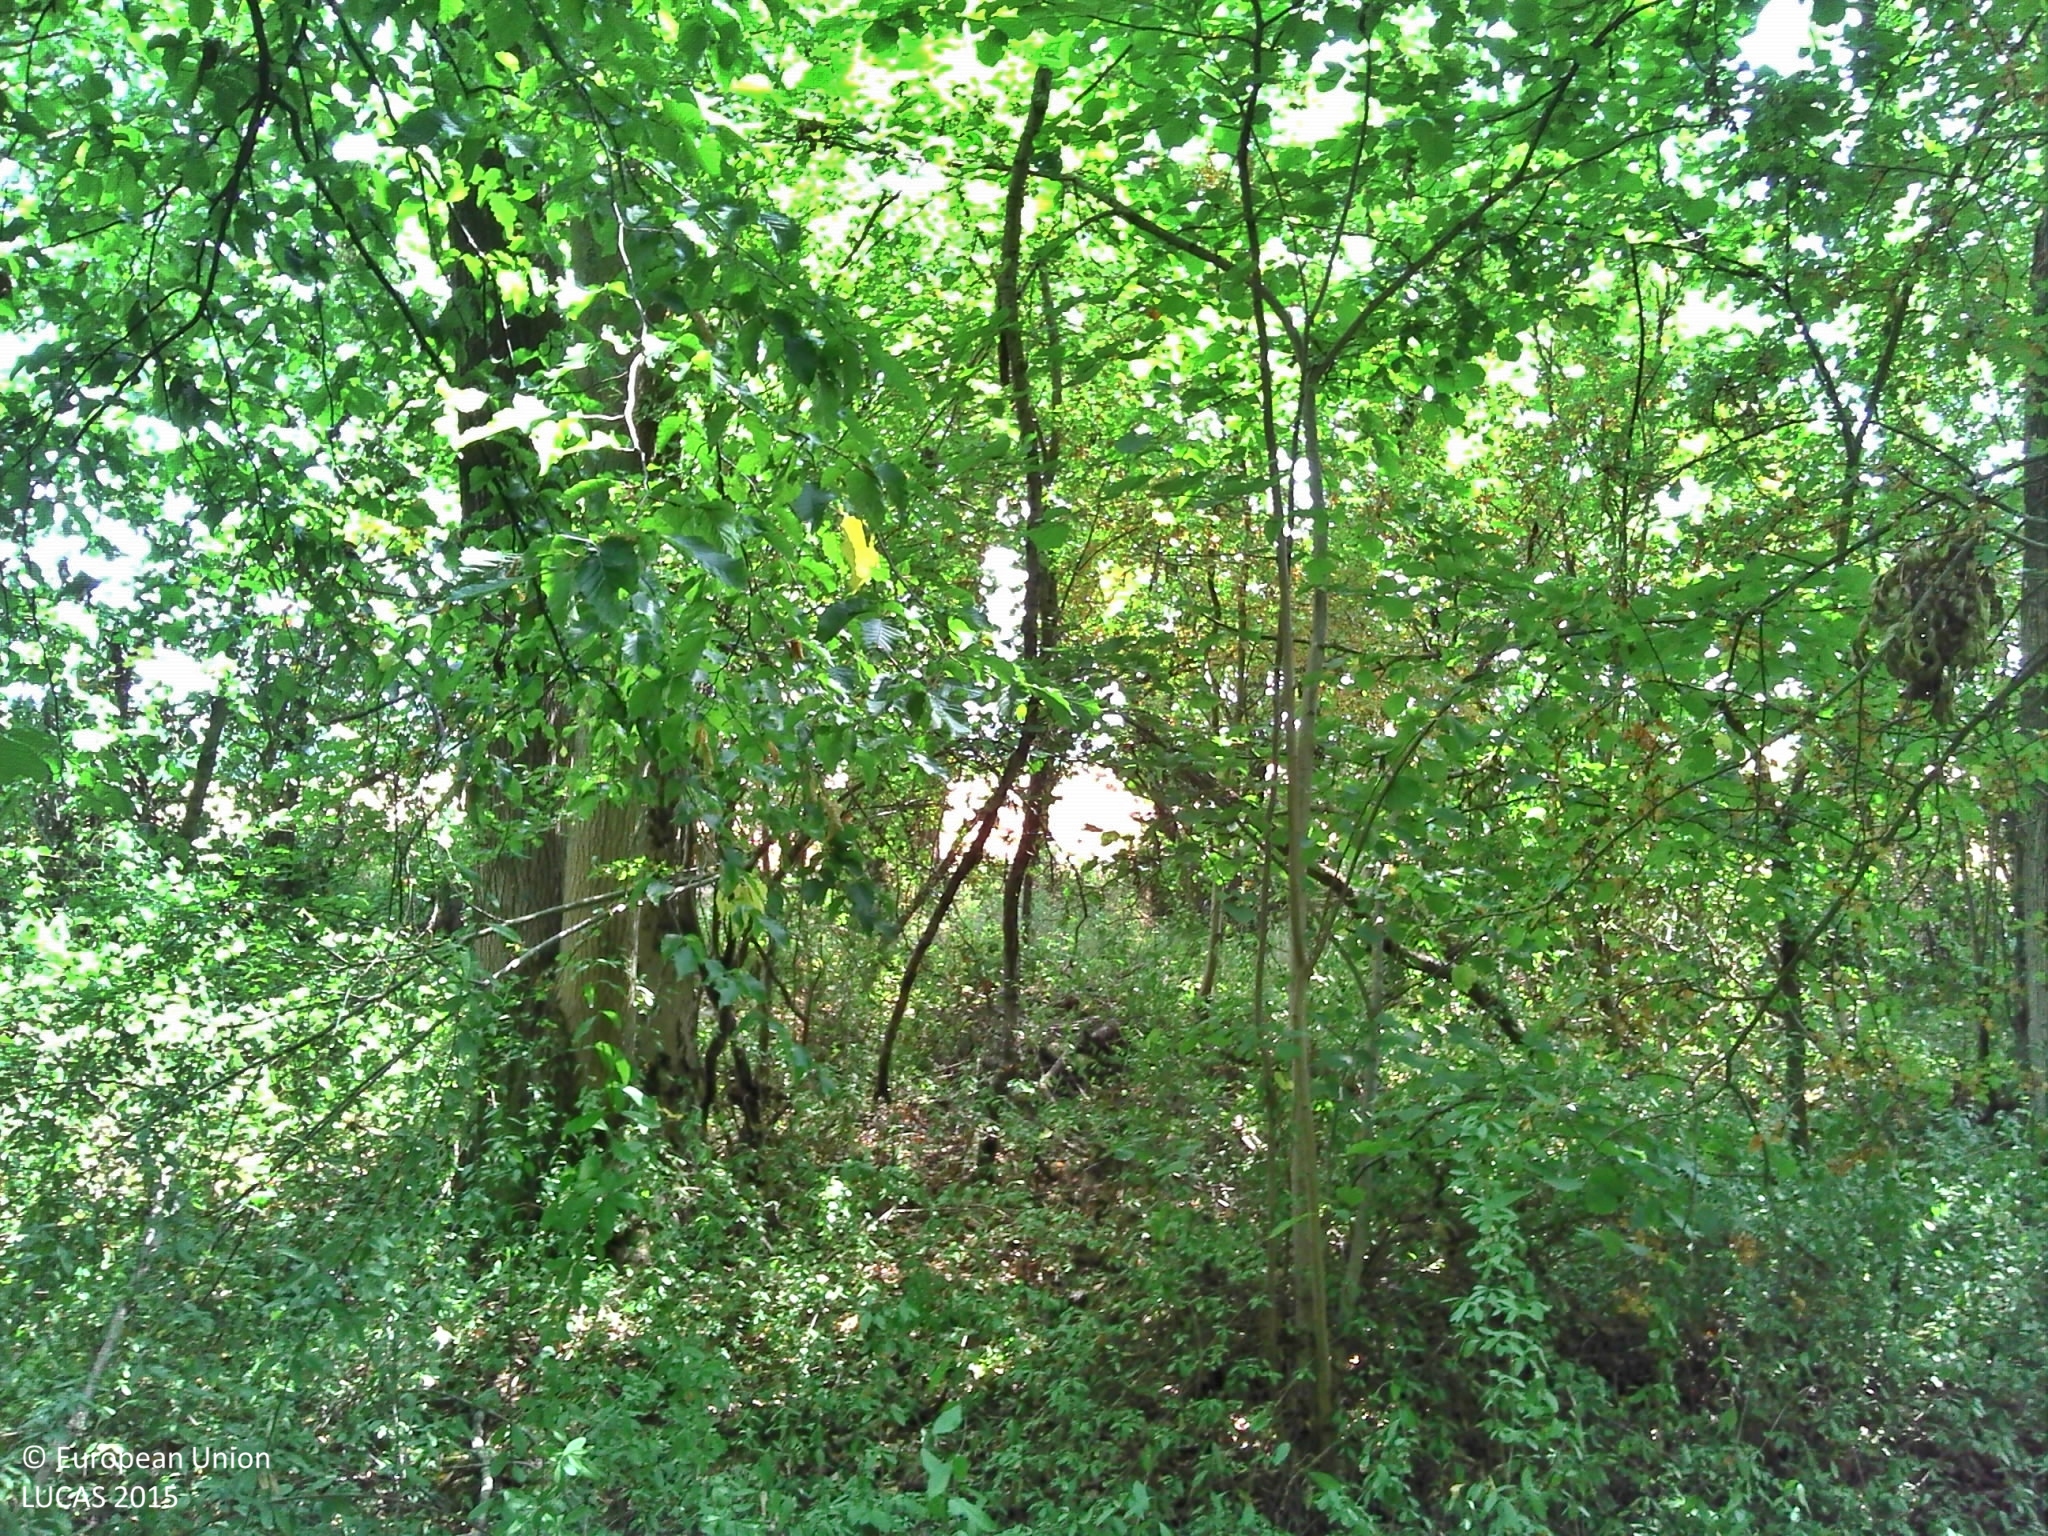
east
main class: Woodland
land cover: Broadleaved woodland
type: mesophytic deciduous forest
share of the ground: > 75 %
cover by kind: broadleaved forest trees 80 %, shrubs 10 %, herbaceous plants 10 %
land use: Forestry
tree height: > 5 m
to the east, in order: Broadleaved woodland; Grass margins; Common wheat
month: July
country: FR
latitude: 49.2236
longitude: 2.3670
